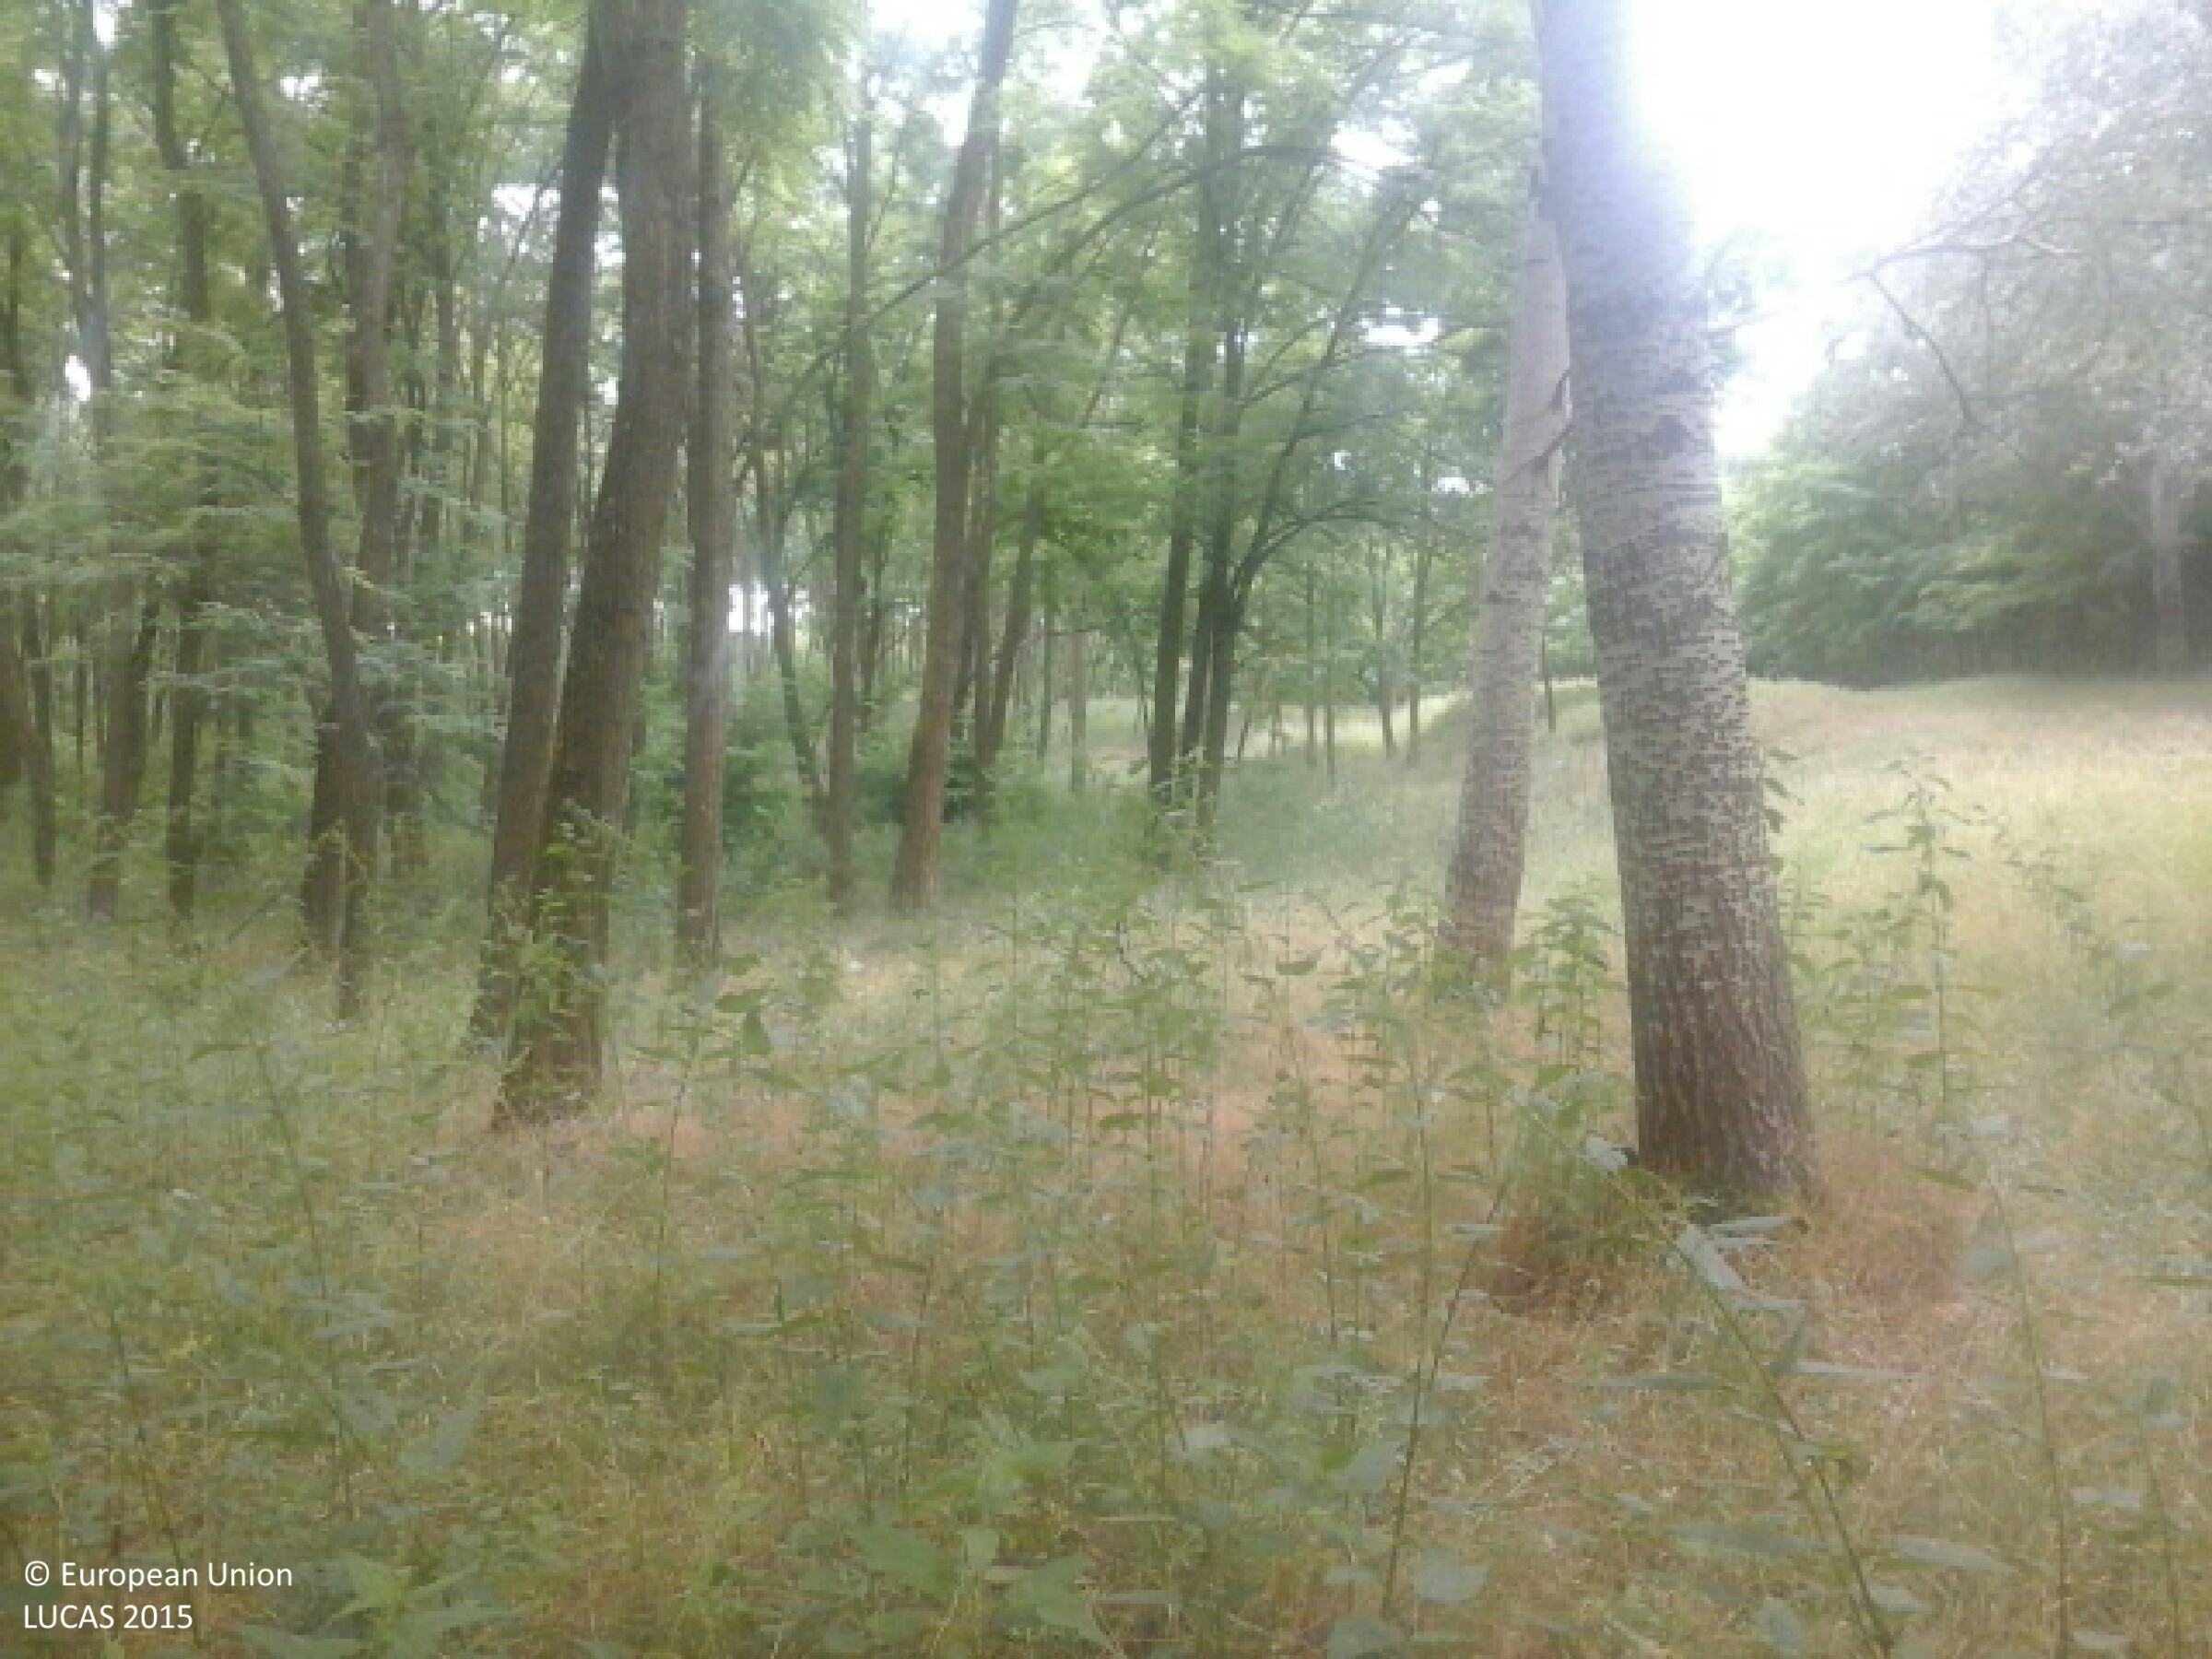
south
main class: Woodland
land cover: Broadleaved woodland
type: mesophytic deciduous forest
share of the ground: > 75 %
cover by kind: broadleaved forest trees 95 %, herbaceous plants 5 %
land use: Forestry
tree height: > 5 m
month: June
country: HU
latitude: 47.9465
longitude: 22.1712
